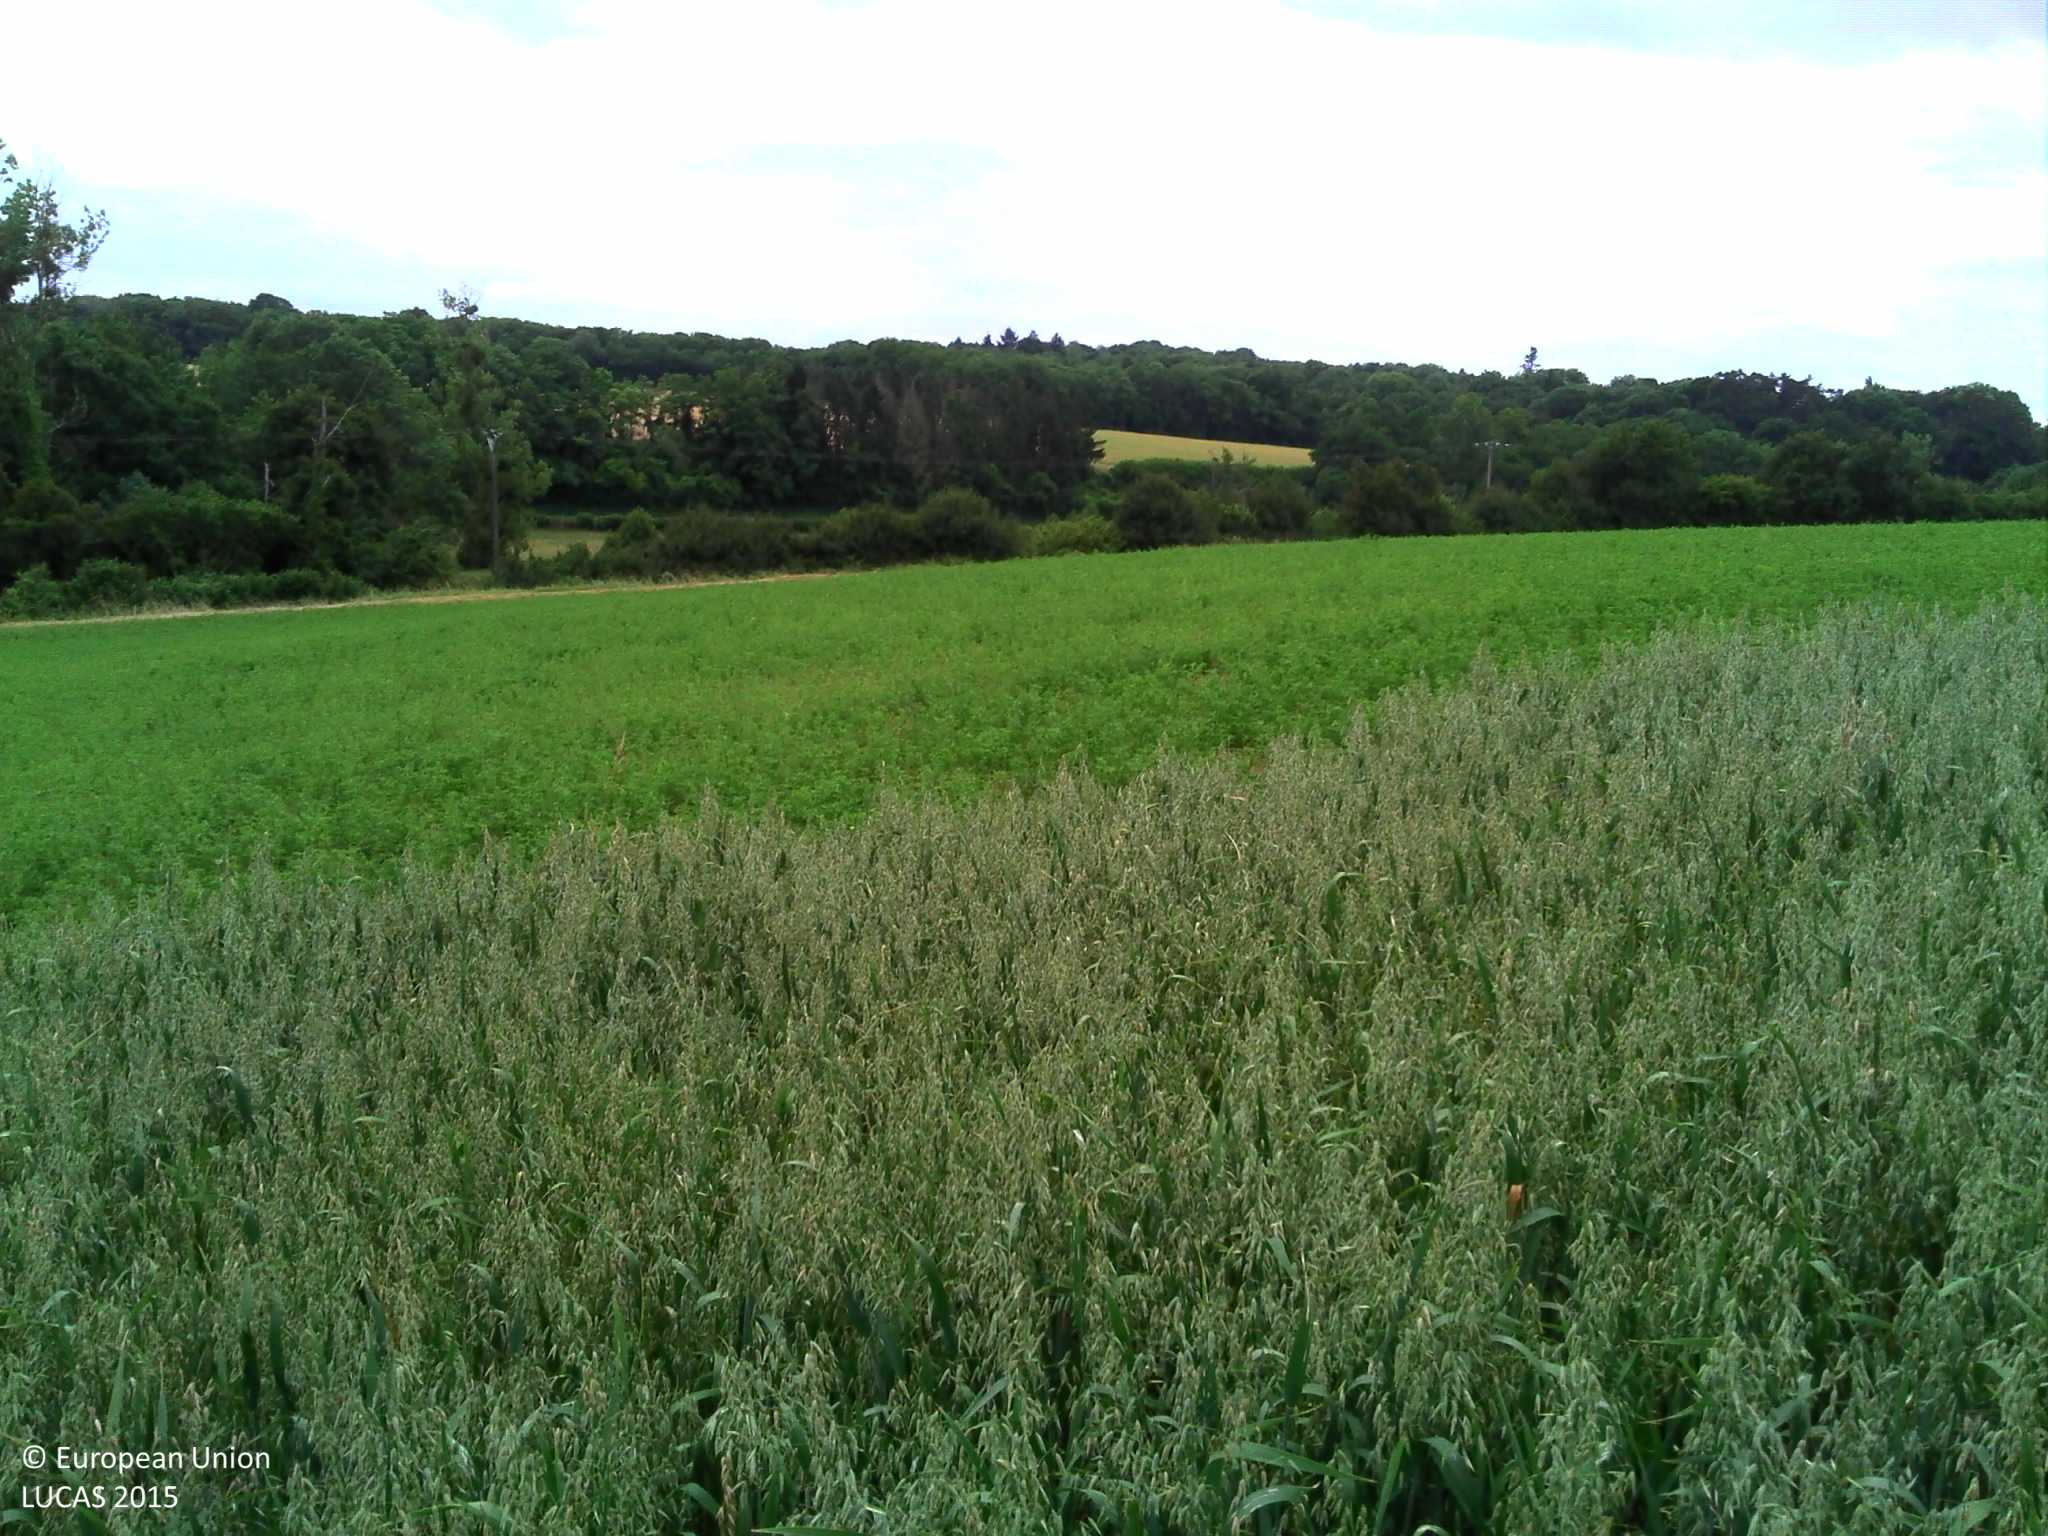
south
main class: Cropland
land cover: Oats
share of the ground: > 75 %
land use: Agriculture (excluding fallow land and kitchen gardens)
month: June
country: FR
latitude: 47.3781
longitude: 3.1477
